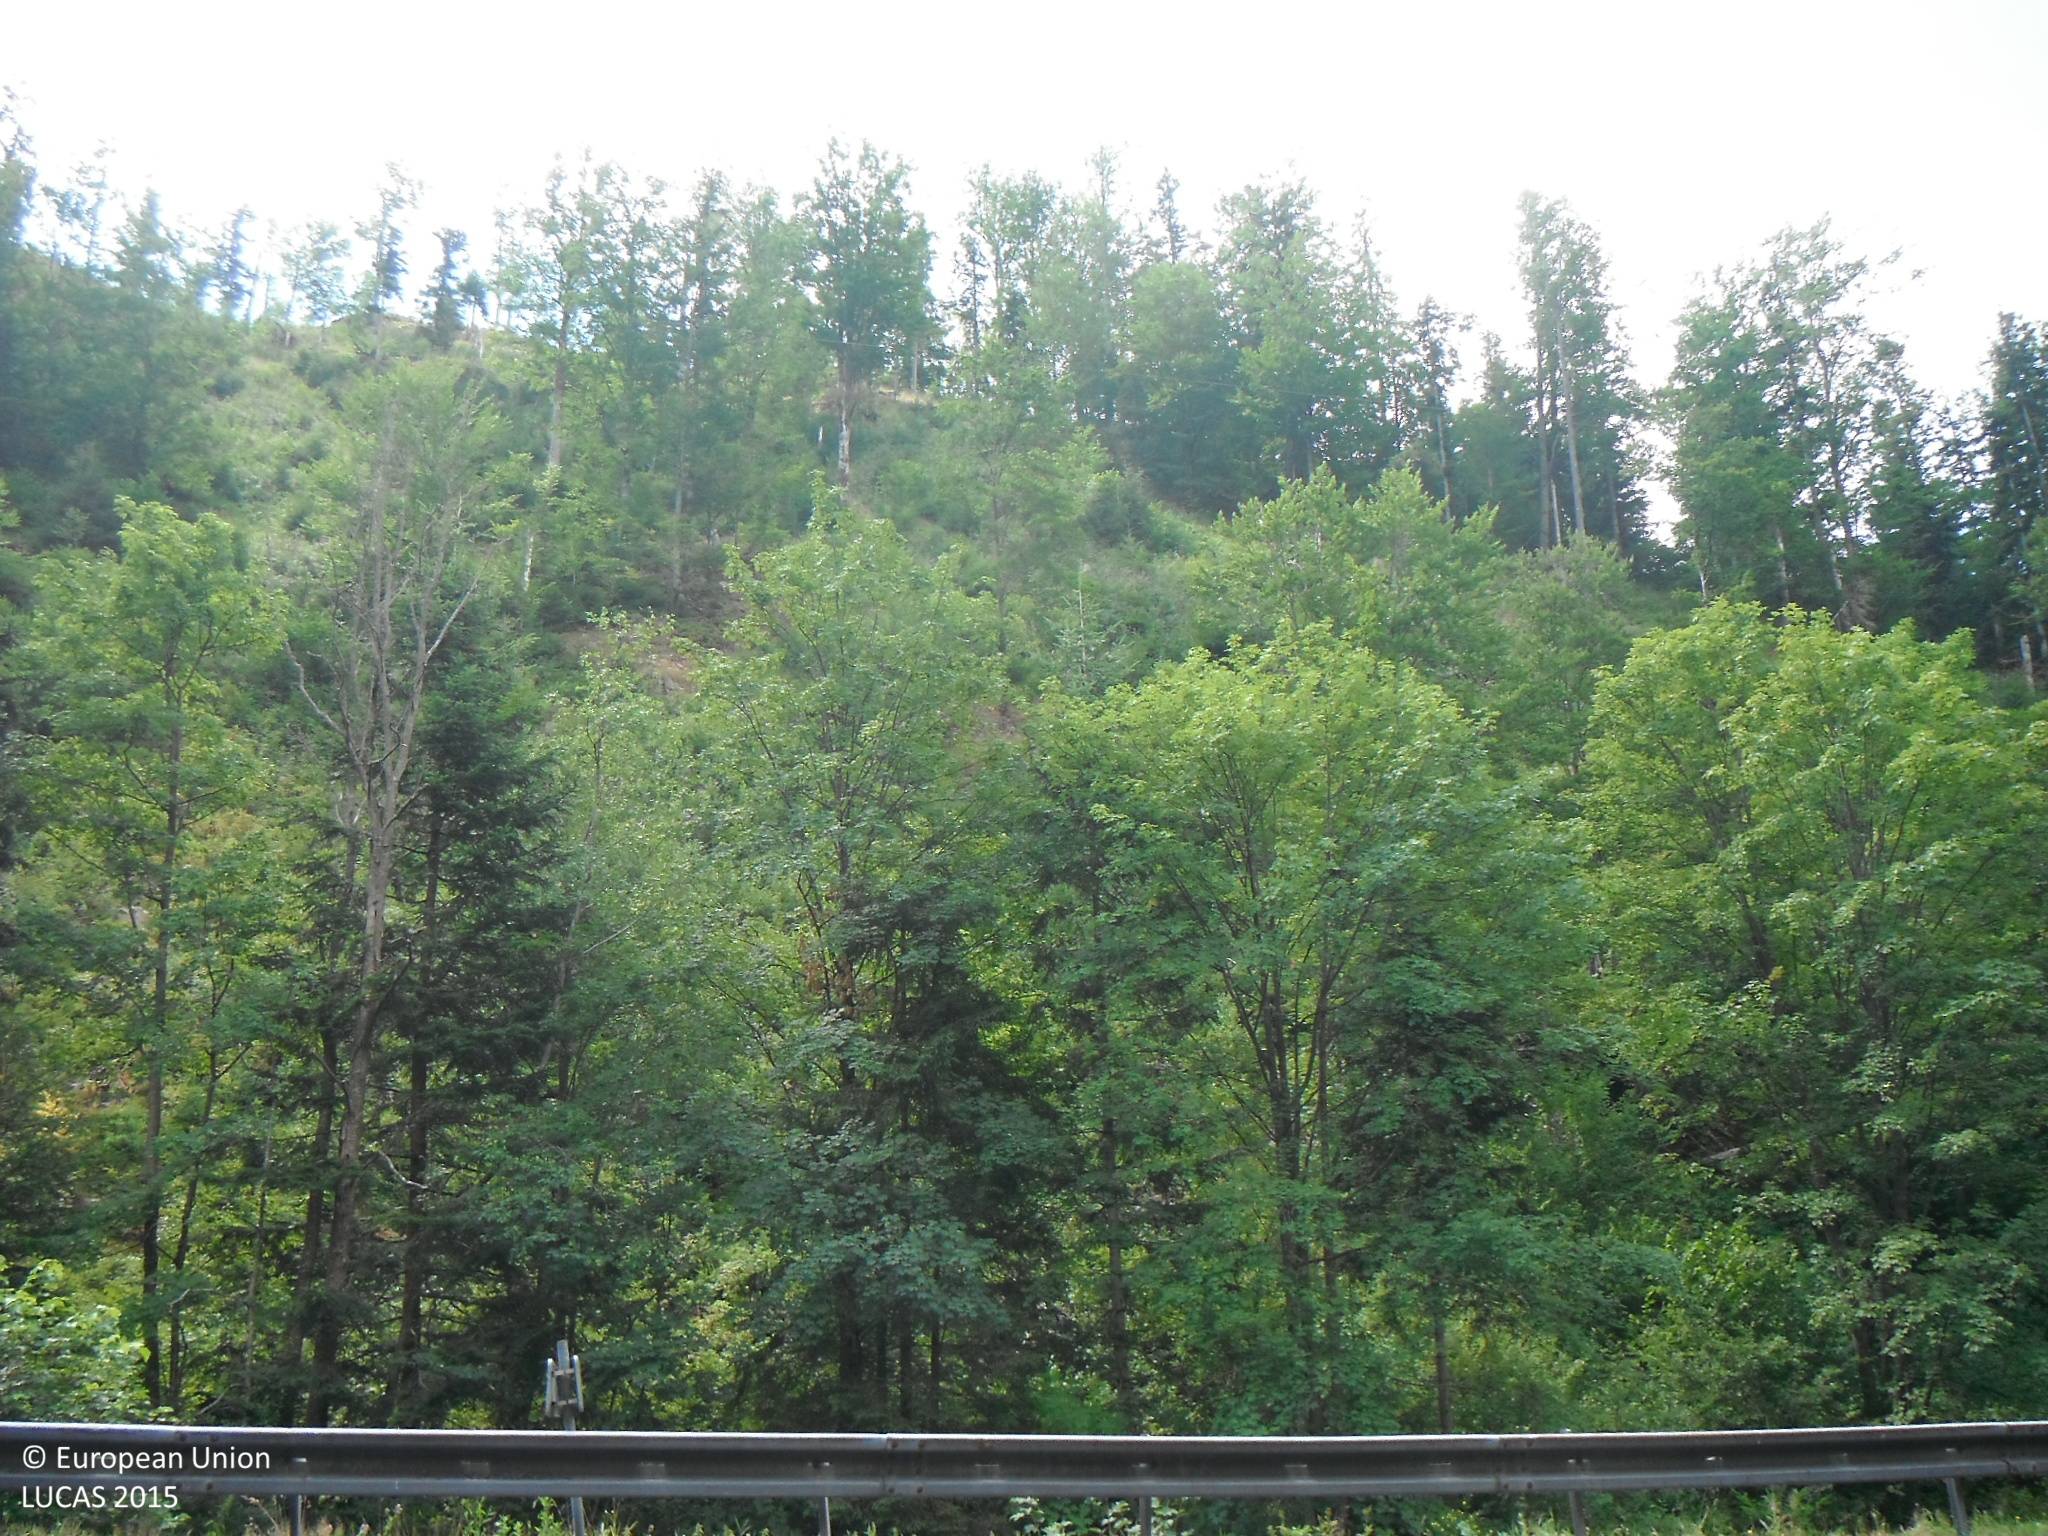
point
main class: Woodland
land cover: Spruce dominated mixed woodland
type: mountainous beech forest
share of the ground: > 75 %
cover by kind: broadleaved forest trees 50 %, coniferous forest trees 25 %, shrubs 15 %, herbaceous plants 10 %
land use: Forestry
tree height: > 5 m
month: July
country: SK
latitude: 48.8848
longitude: 19.6689
